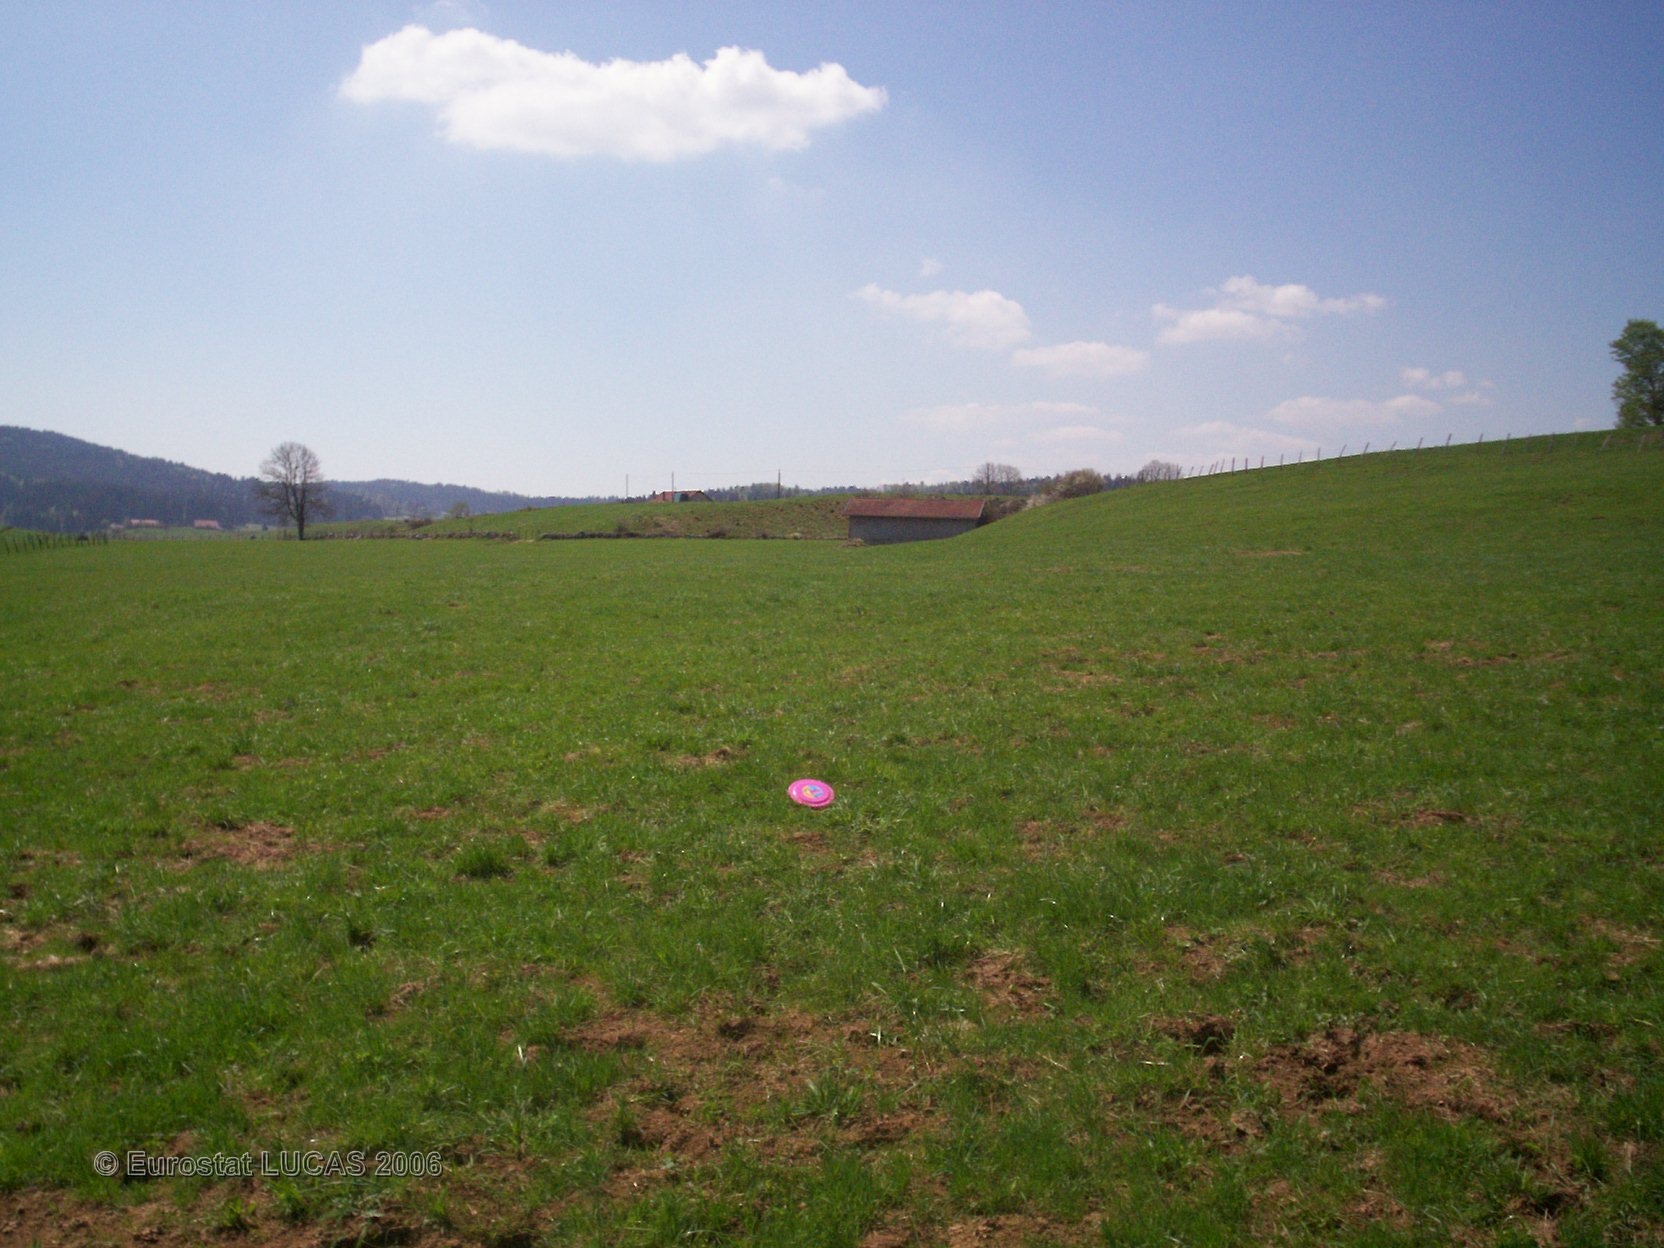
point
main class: Grassland
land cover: Grassland without tree/shrub cover
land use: Agriculture (excluding fallow land and kitchen gardens)
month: May
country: FR
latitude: 47.1096
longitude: 6.6418
